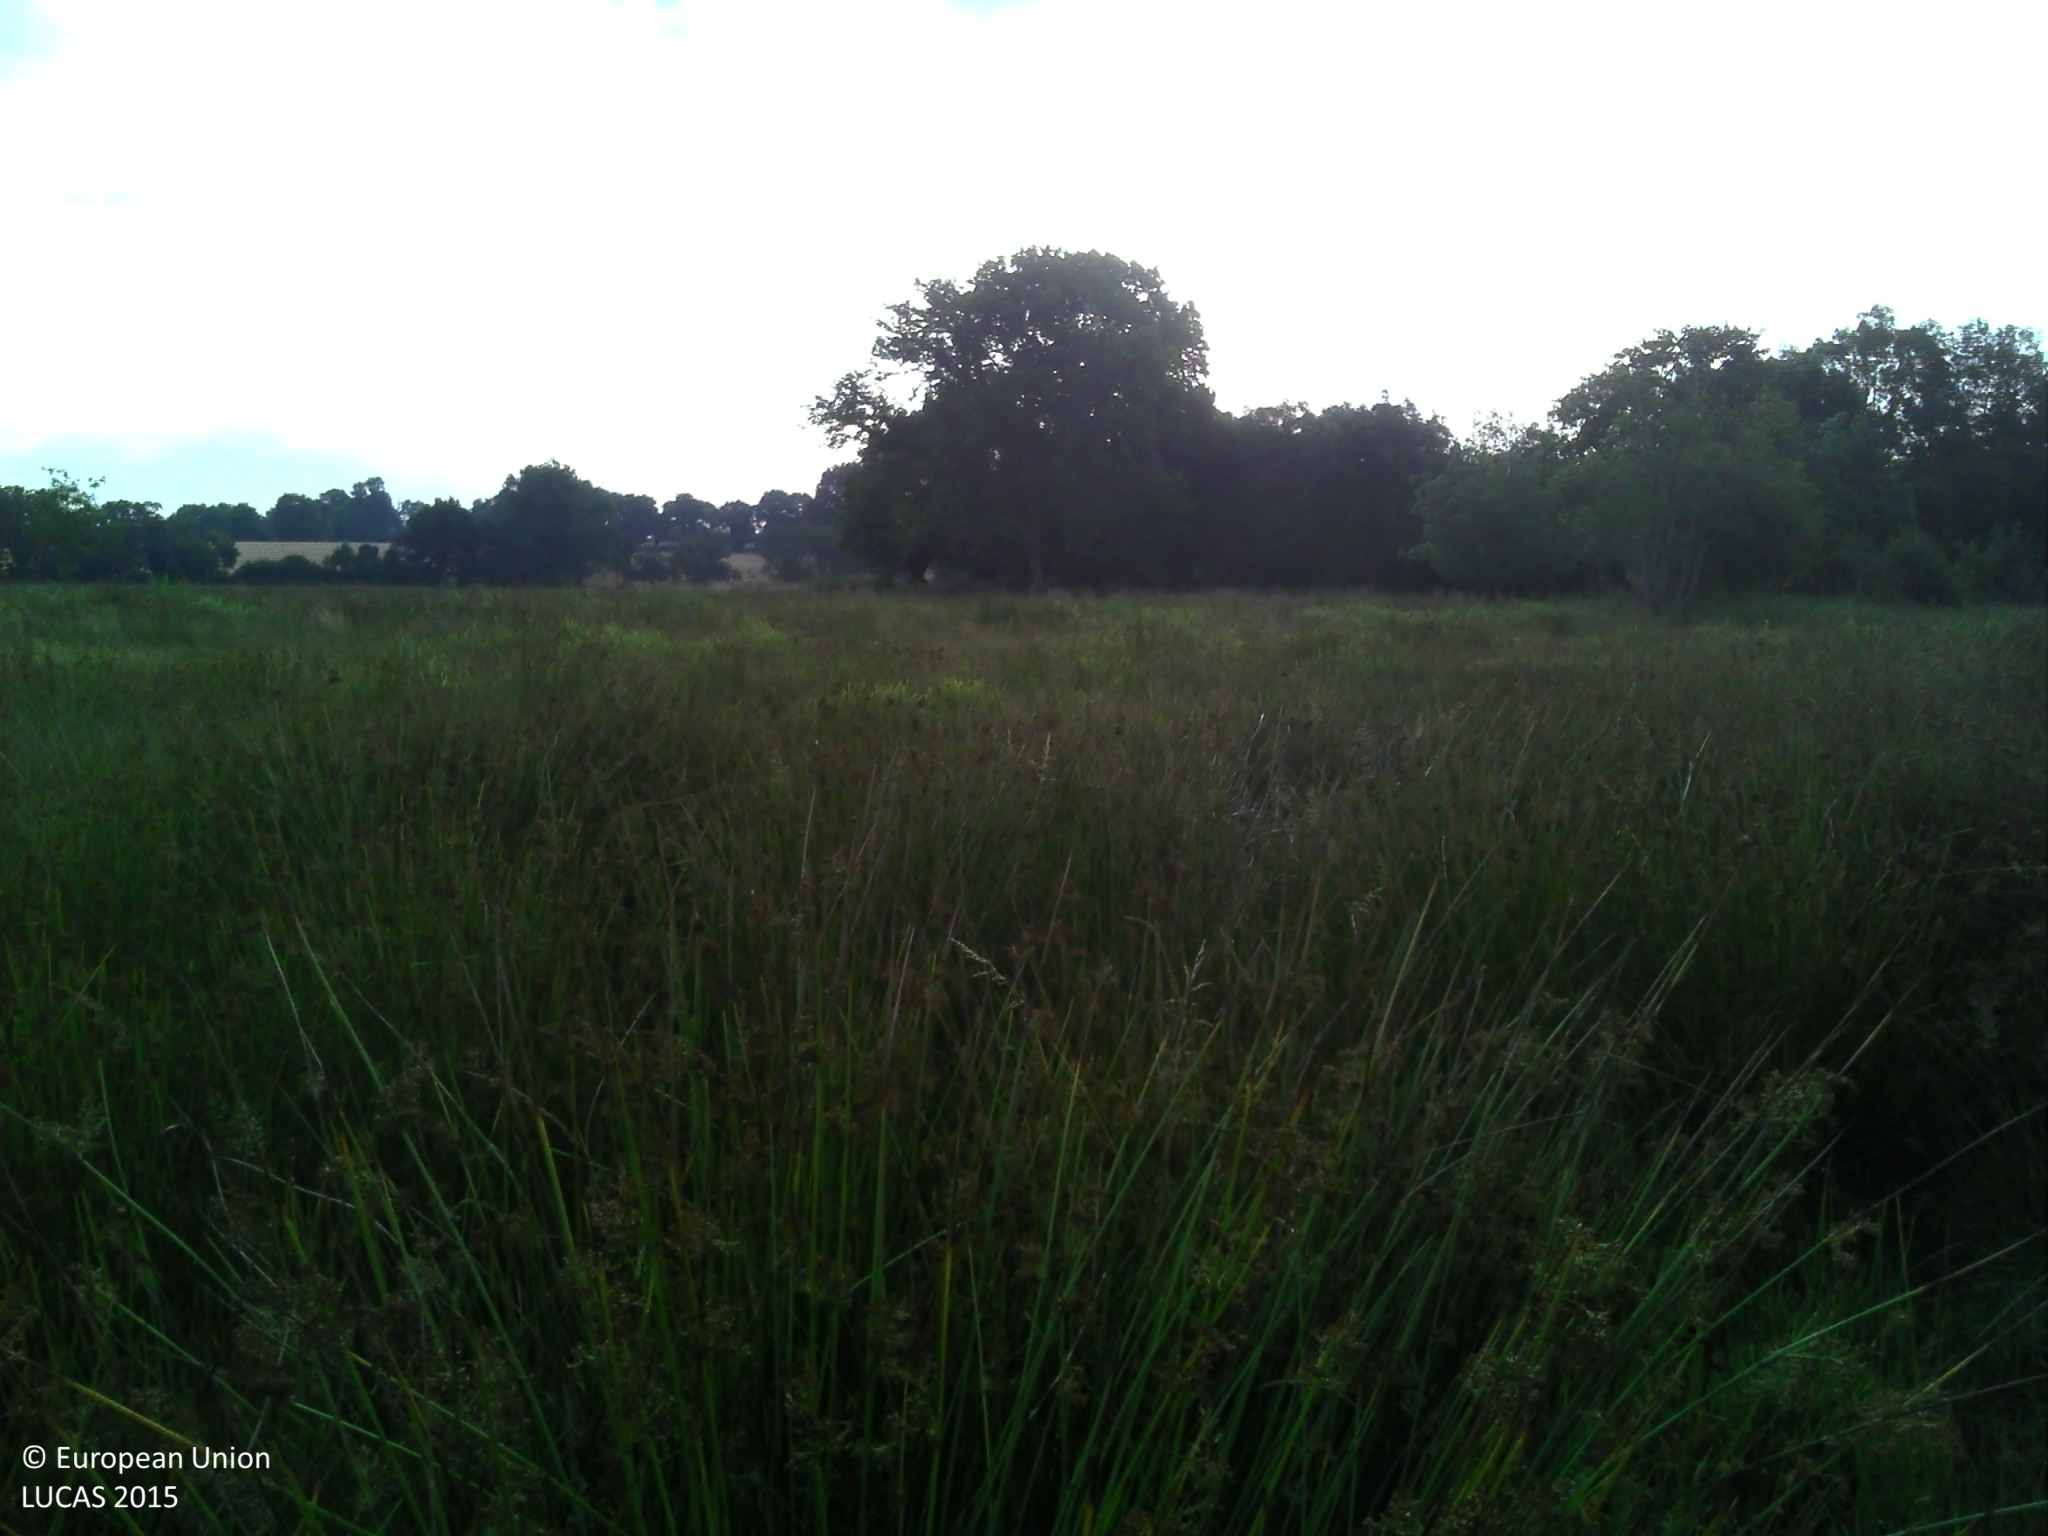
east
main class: Grassland
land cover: Grassland without tree/shrub cover
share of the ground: > 75 %
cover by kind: herbaceous plants 100 %
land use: Agriculture (excluding fallow land and kitchen gardens)
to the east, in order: Grassland without tree/shrub cover; Electric lines; Grassland without tree/shrub cover; Fences; Broadleaved woodland; Grassland without tree/shrub cover; Broadleaved woodland; Grassland without tree/shrub cover; Broadleaved woodland; Artificial constructions in urban areas
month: July
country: FR
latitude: 47.2606
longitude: -1.7940
